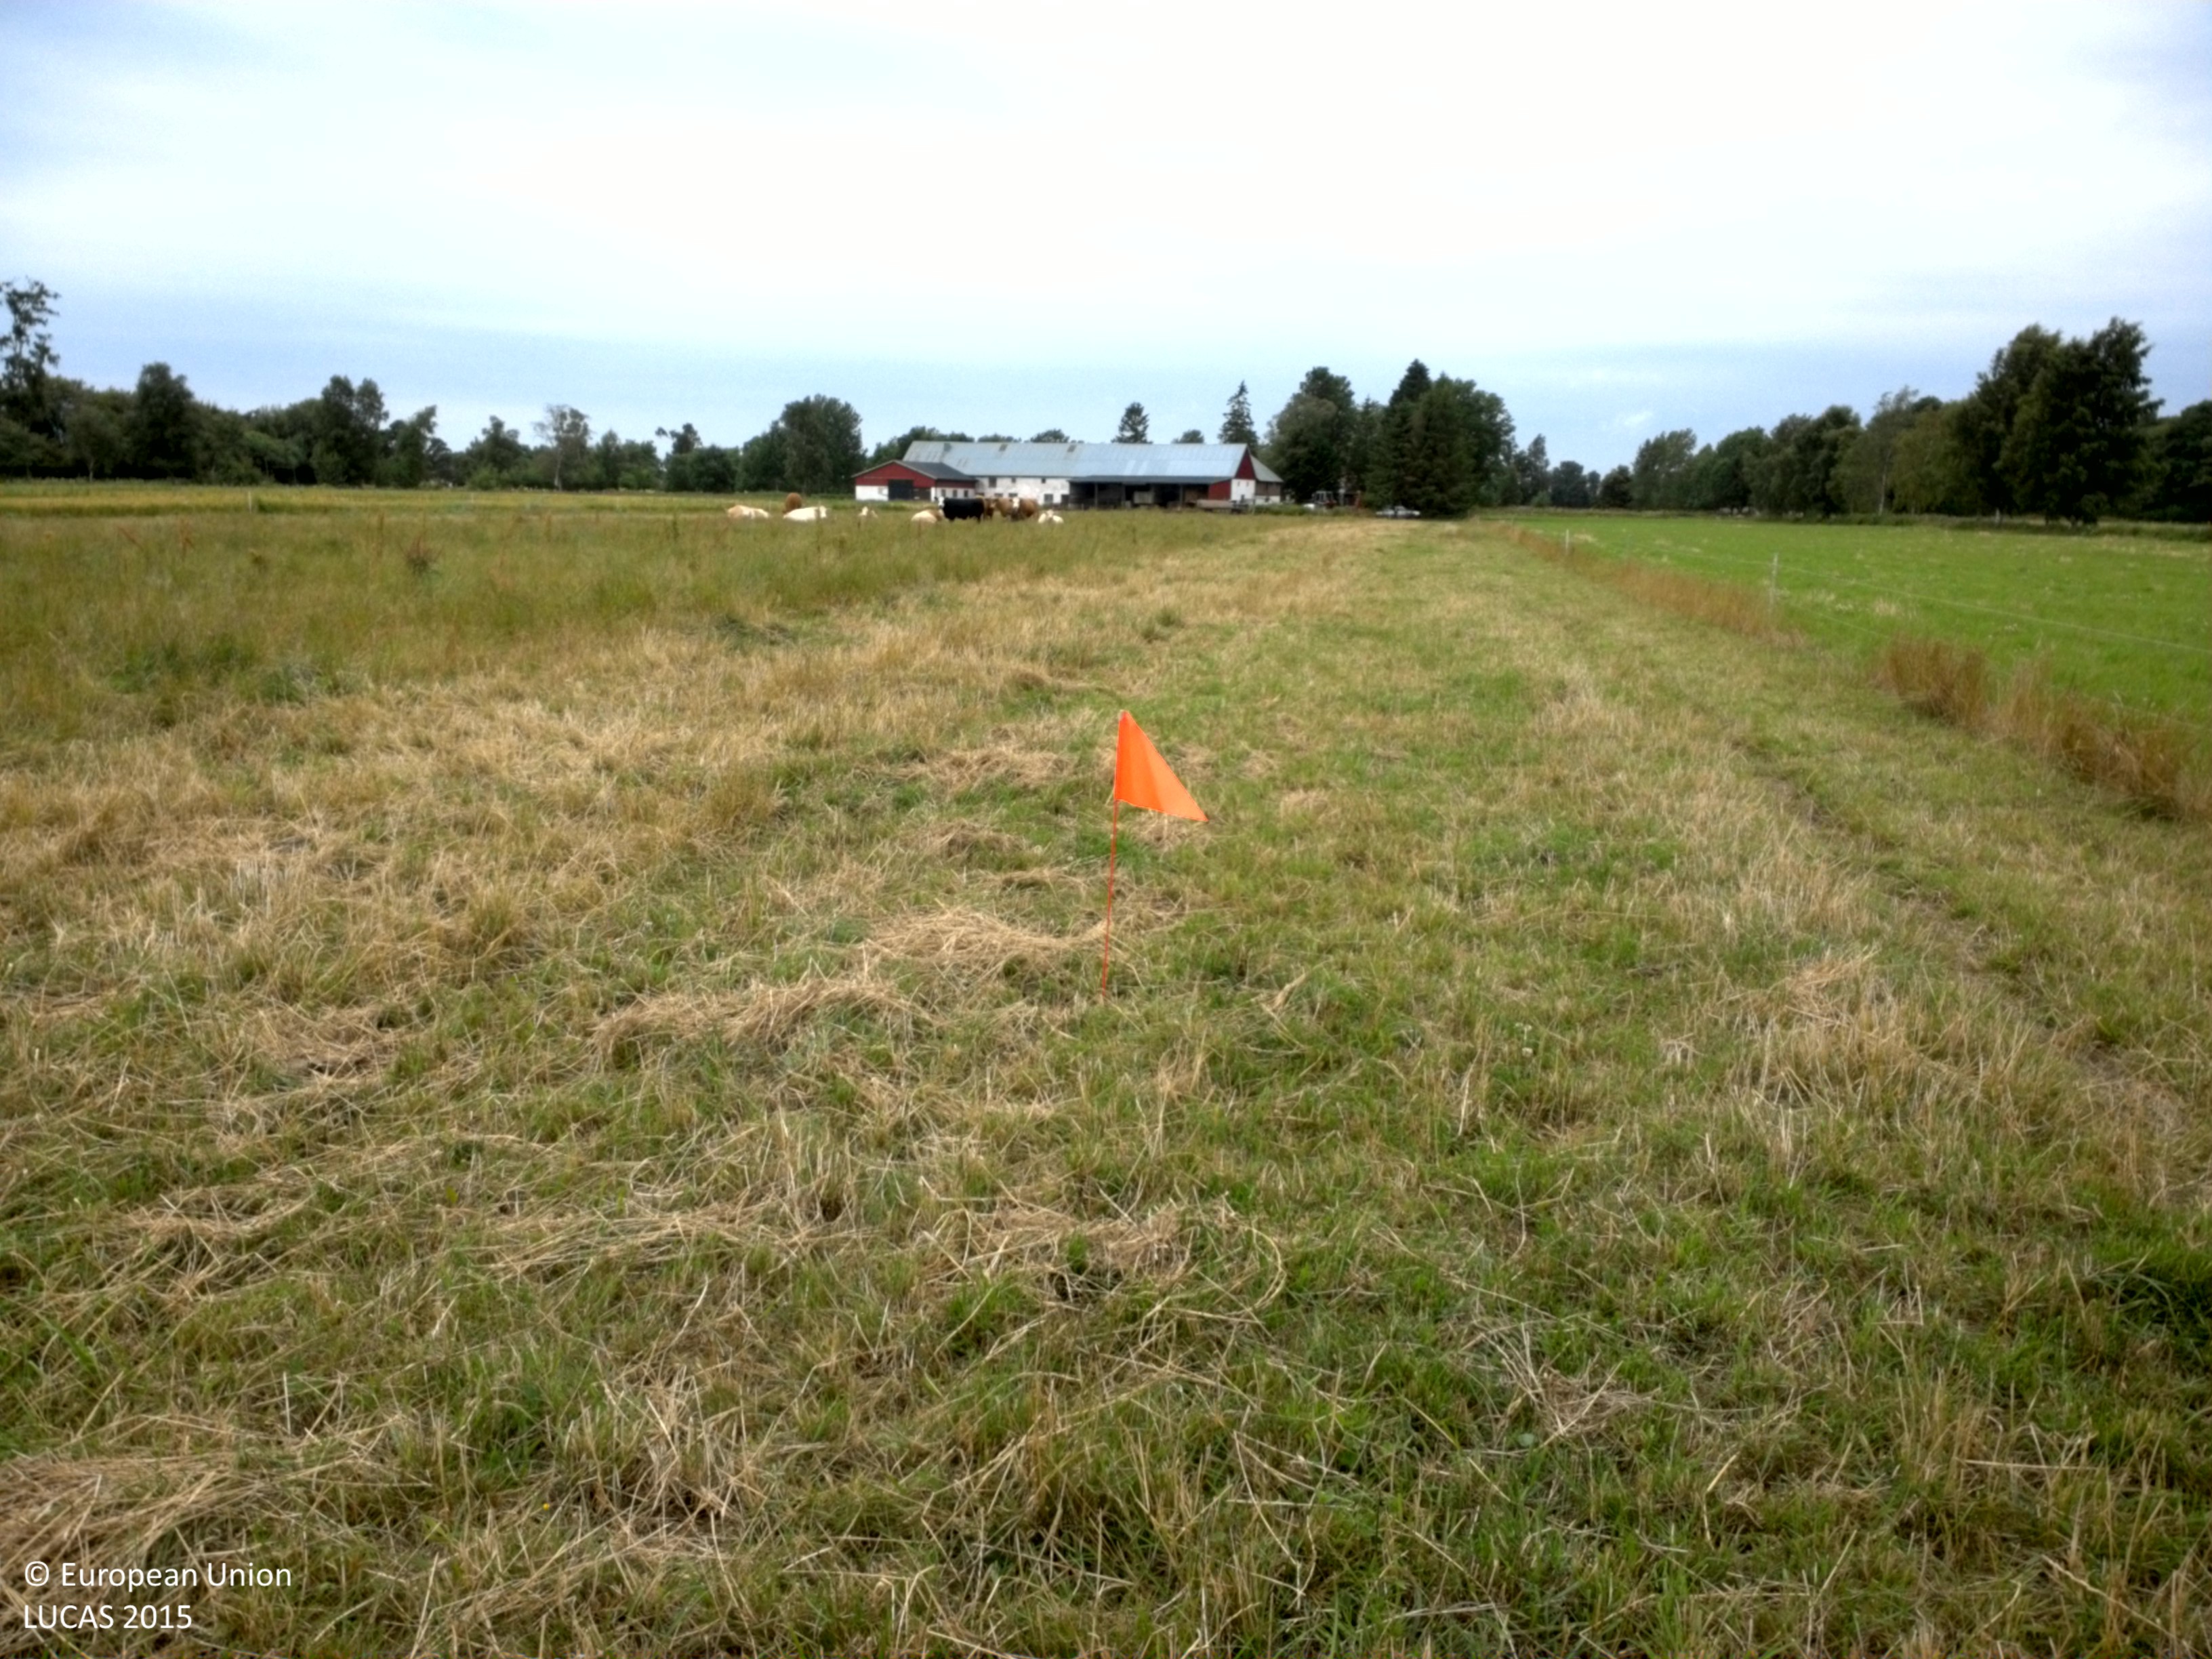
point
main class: Cropland
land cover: Temporary grasslands
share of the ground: > 75 %
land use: Agriculture (excluding fallow land and kitchen gardens)
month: July
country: SE
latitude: 57.2528
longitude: 18.6462
